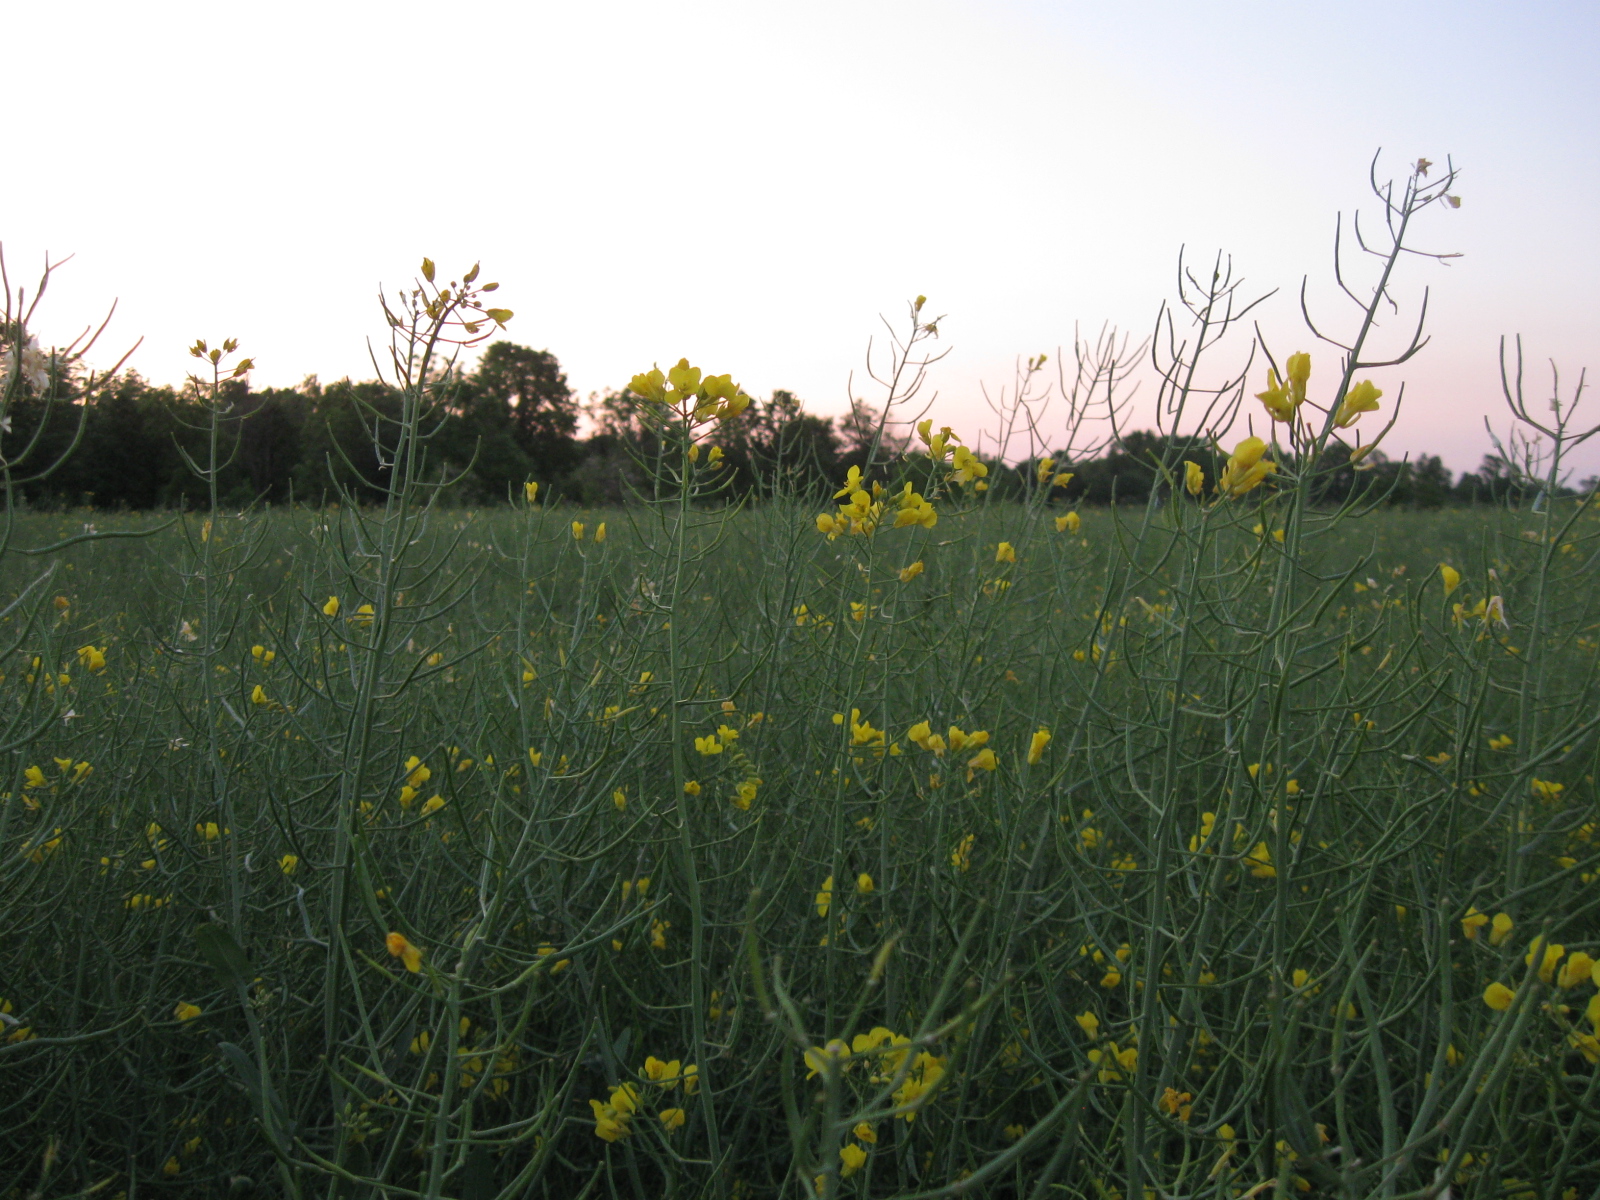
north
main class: Cropland
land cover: Rape and turnip rape
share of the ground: > 75 %
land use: Agriculture (excluding fallow land and kitchen gardens)
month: June
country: LT
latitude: 54.4827
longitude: 23.8413
